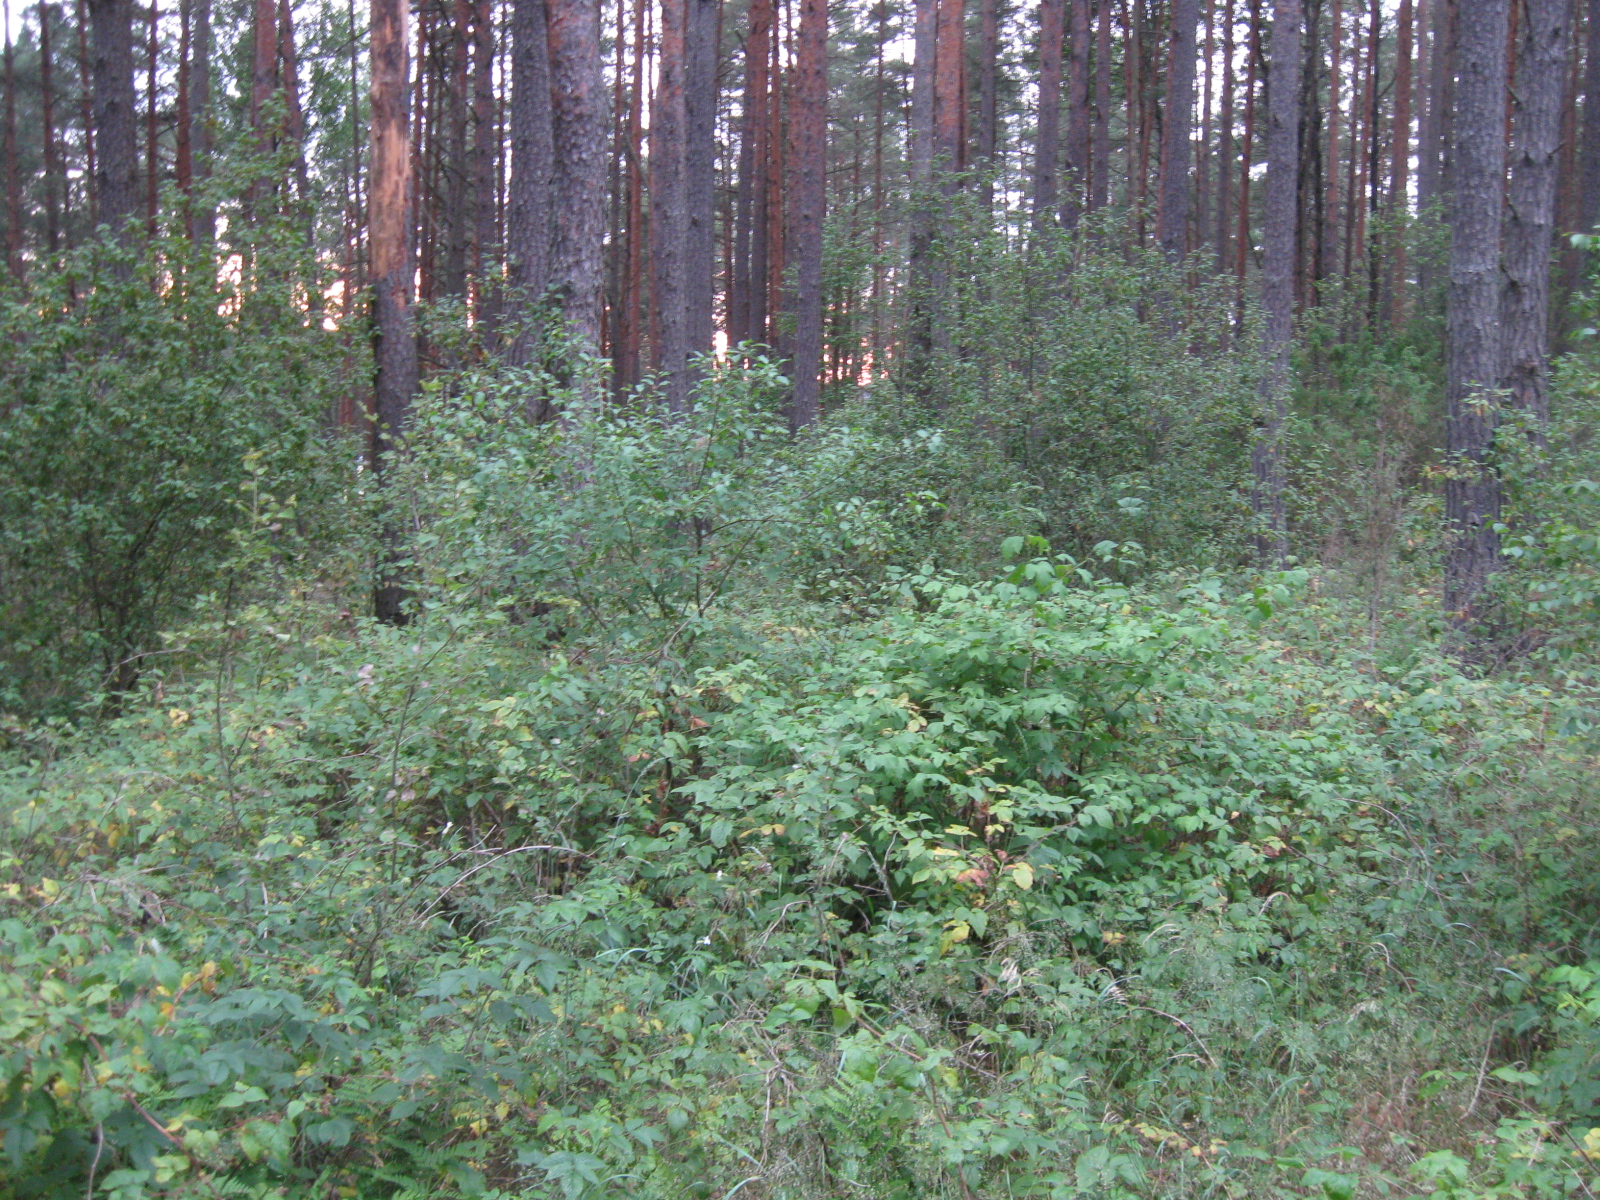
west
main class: Shrubland
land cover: Shrubland with sparse tree cover
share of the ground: > 75 %
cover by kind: shrubs 80 %, herbaceous plants 15 %, broadleaved forest trees 5 %
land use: Electricity, gas and thermal power distribution
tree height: < 5 m
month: June
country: LT
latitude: 54.1494
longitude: 24.1980
